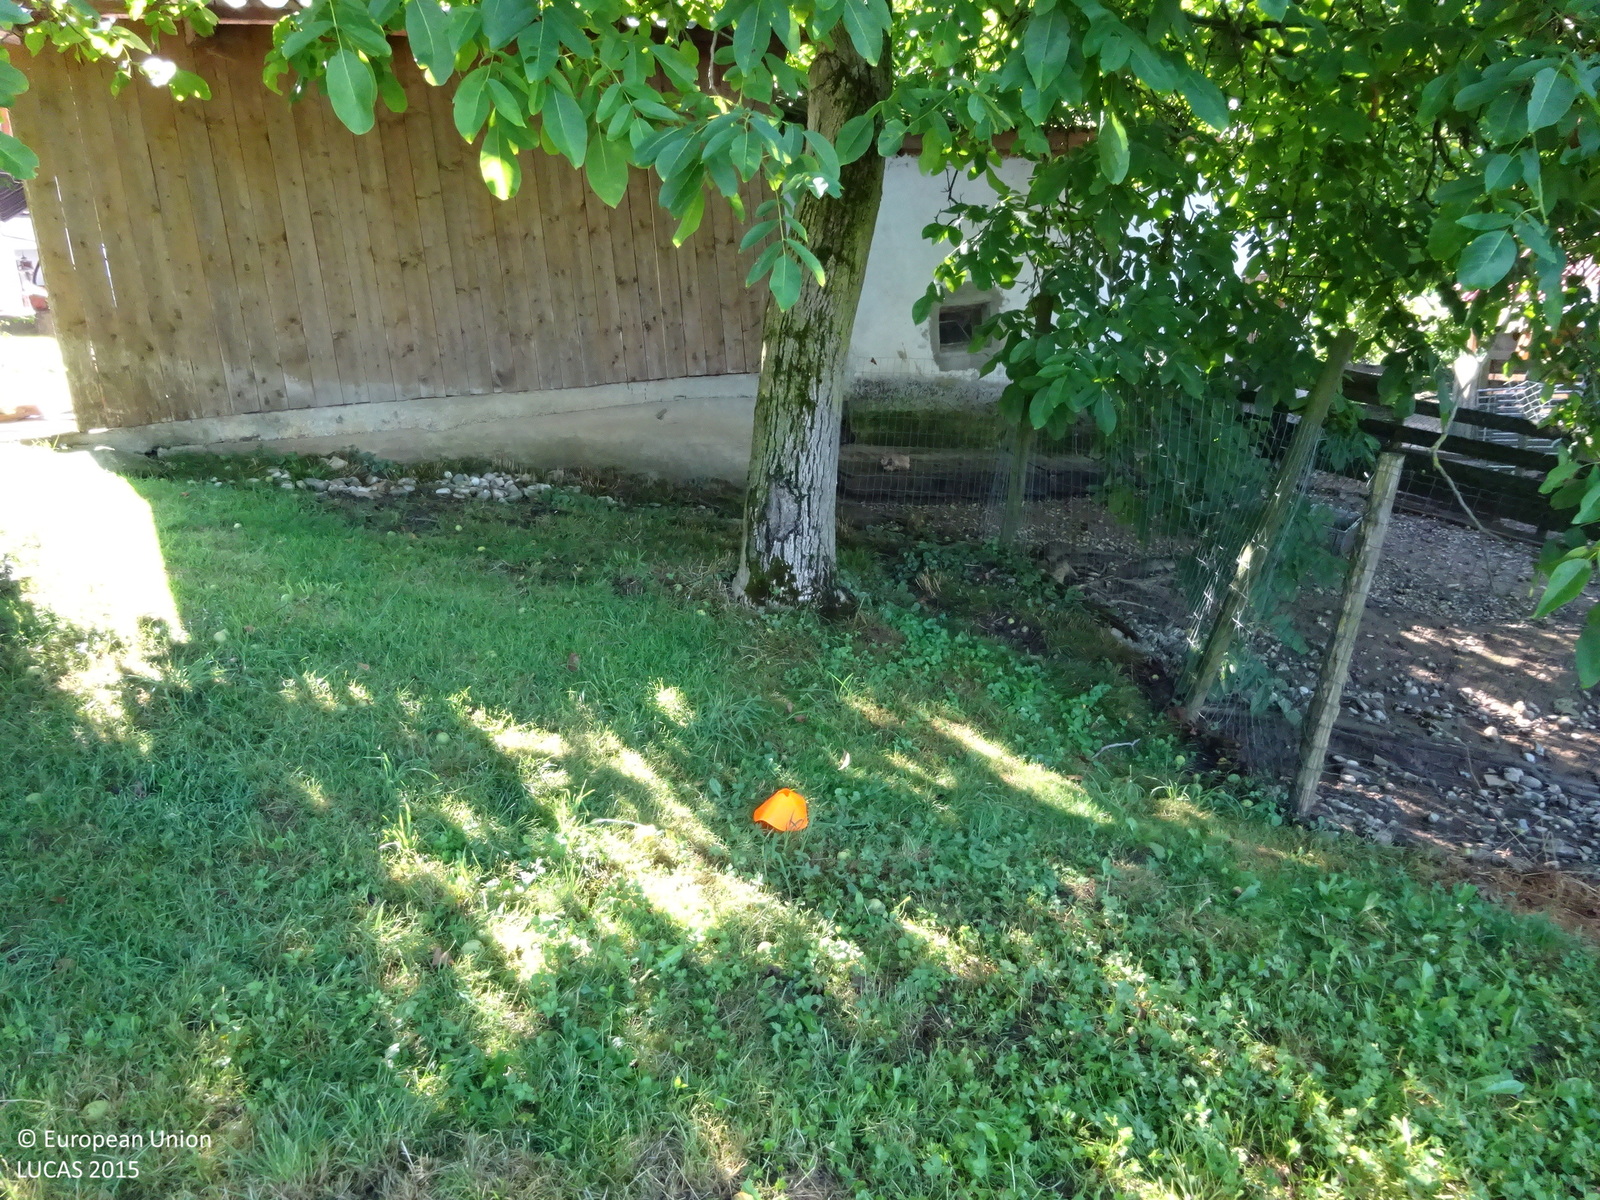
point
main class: Cropland
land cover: Nuts trees
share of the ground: 10 - 25 %
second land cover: Grassland without tree/shrub cover
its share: > 75 %
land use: Agriculture (excluding fallow land and kitchen gardens)
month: July
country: AT
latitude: 46.9228
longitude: 15.3179
